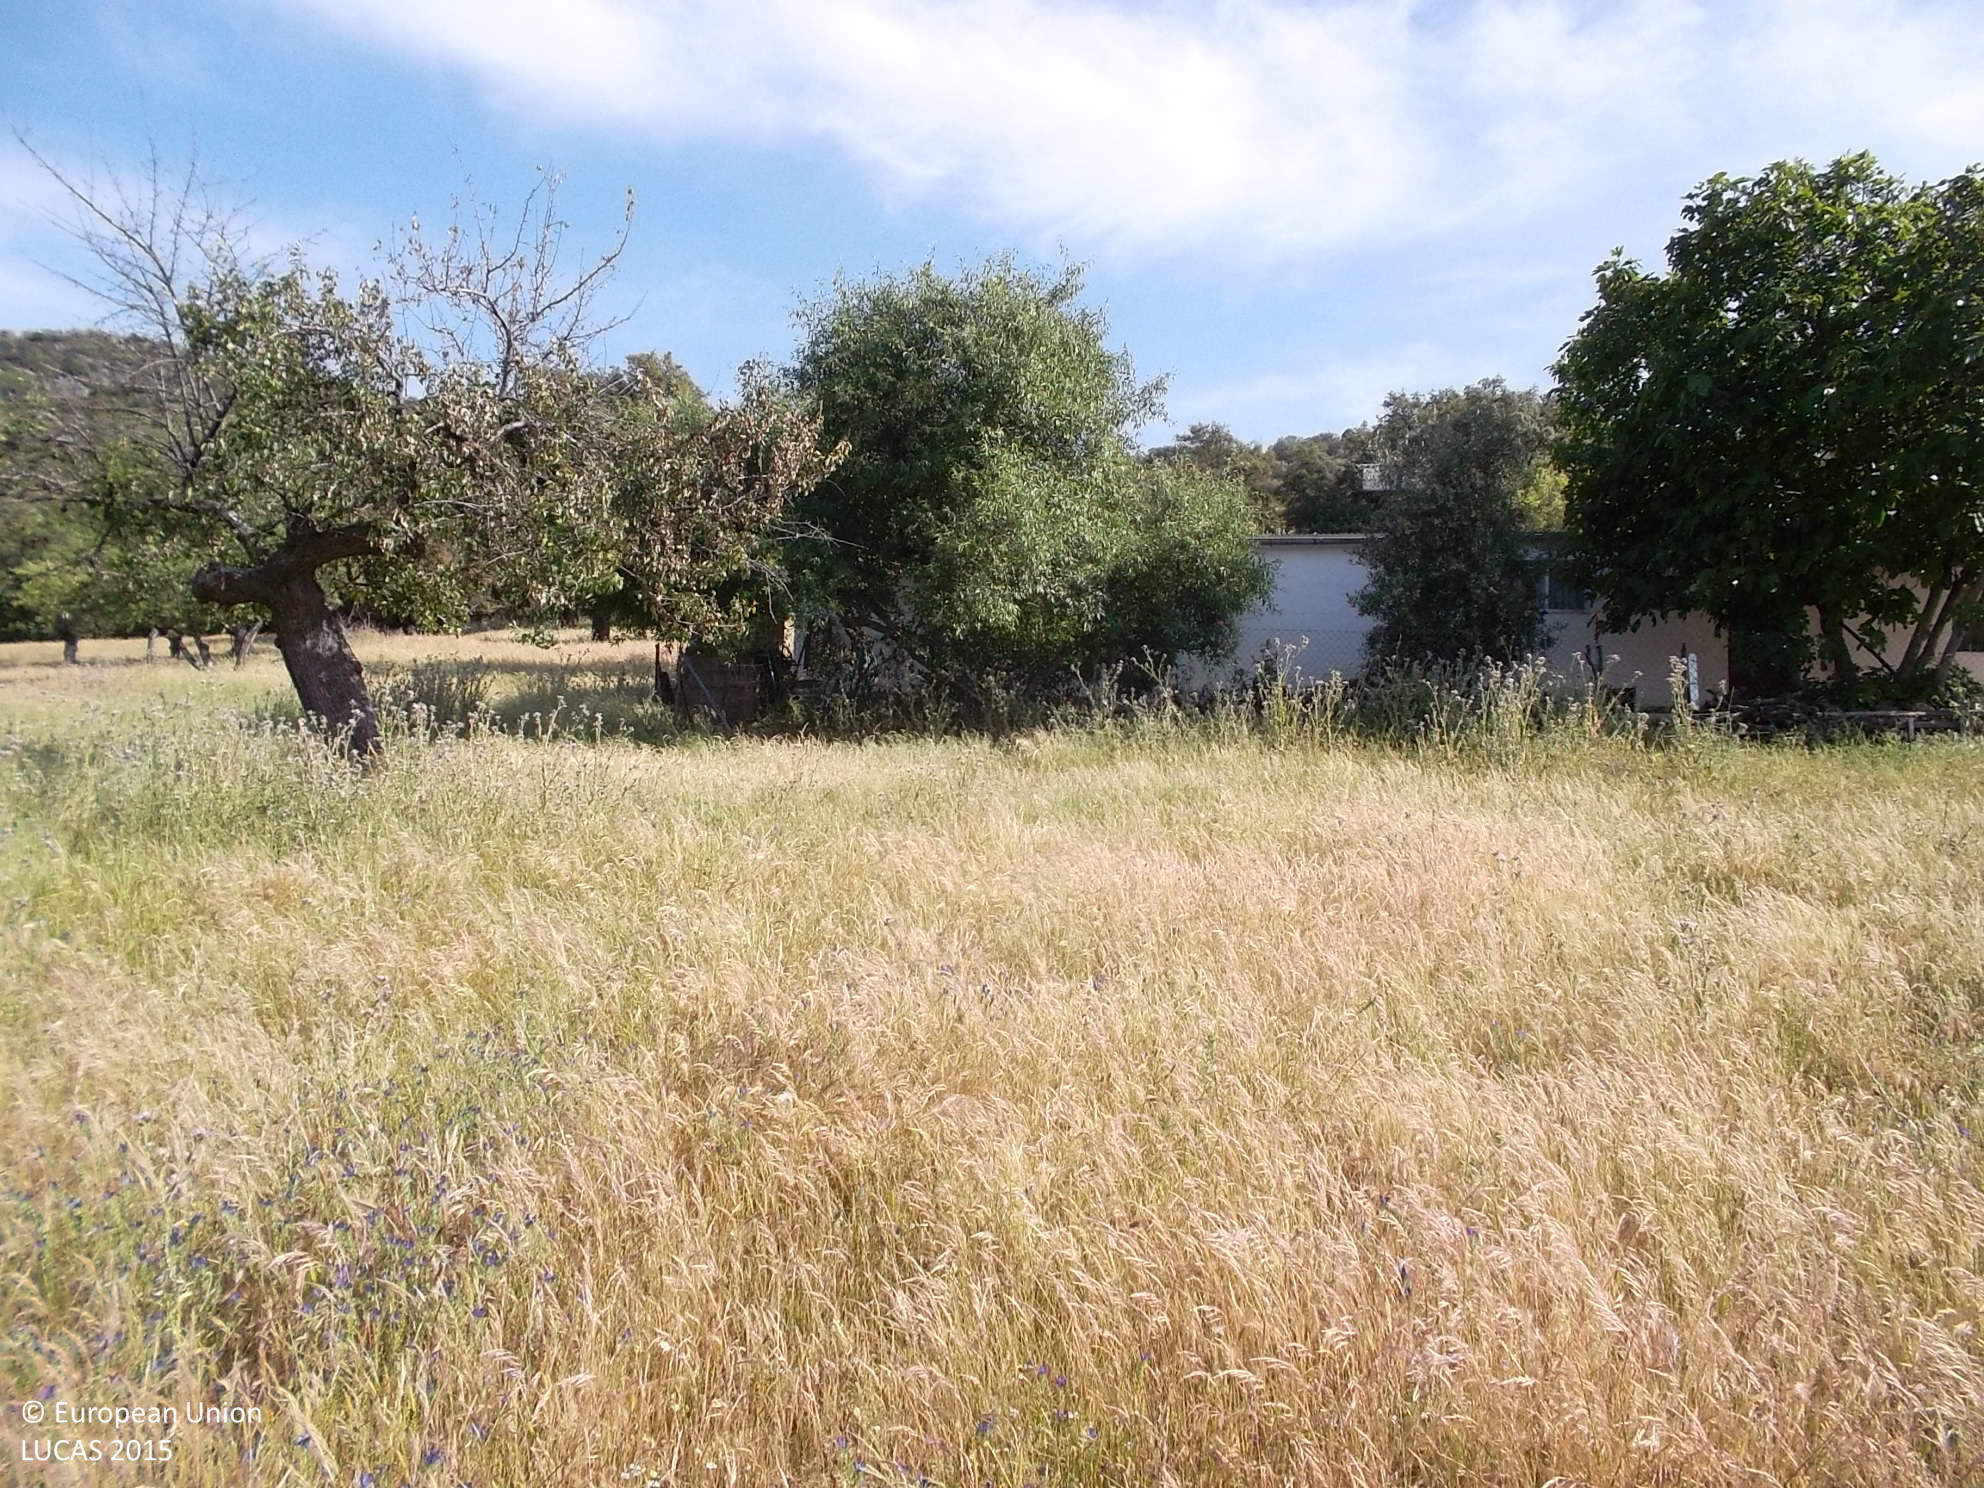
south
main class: Grassland
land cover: Grassland without tree/shrub cover
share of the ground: > 75 %
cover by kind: herbaceous plants 100 %
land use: Agriculture (excluding fallow land and kitchen gardens)
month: May
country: ES
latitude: 38.7677
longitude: -4.8185
